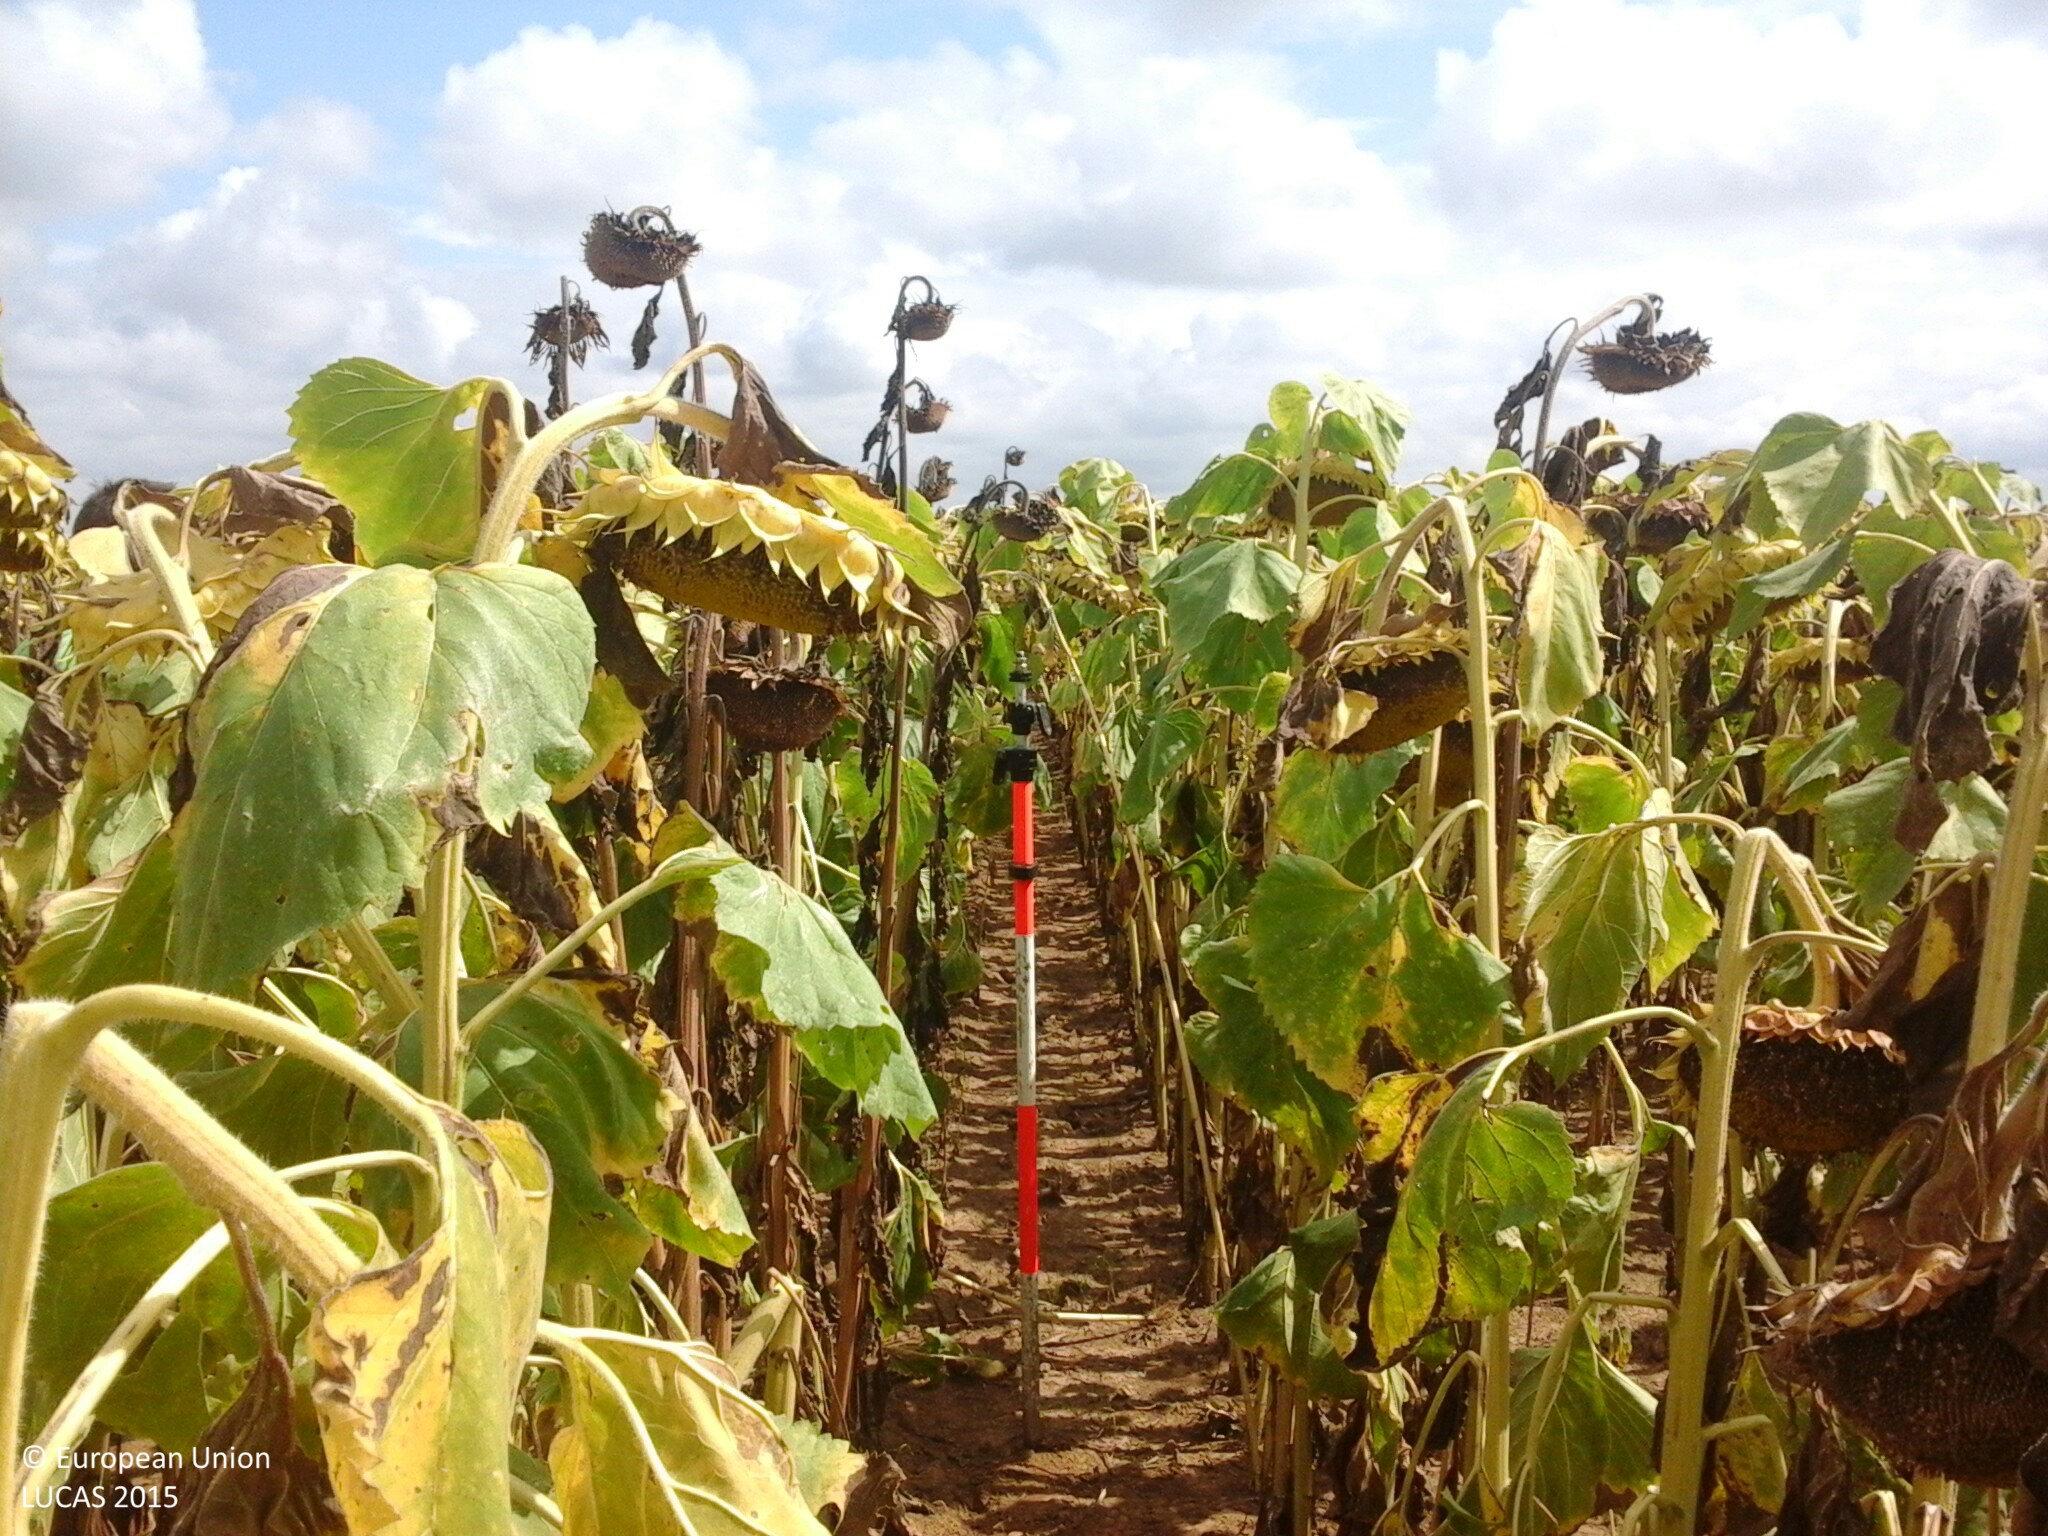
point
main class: Cropland
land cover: Sunflower
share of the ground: > 75 %
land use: Agriculture (excluding fallow land and kitchen gardens)
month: August
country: HU
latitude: 46.9964
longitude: 21.5474
